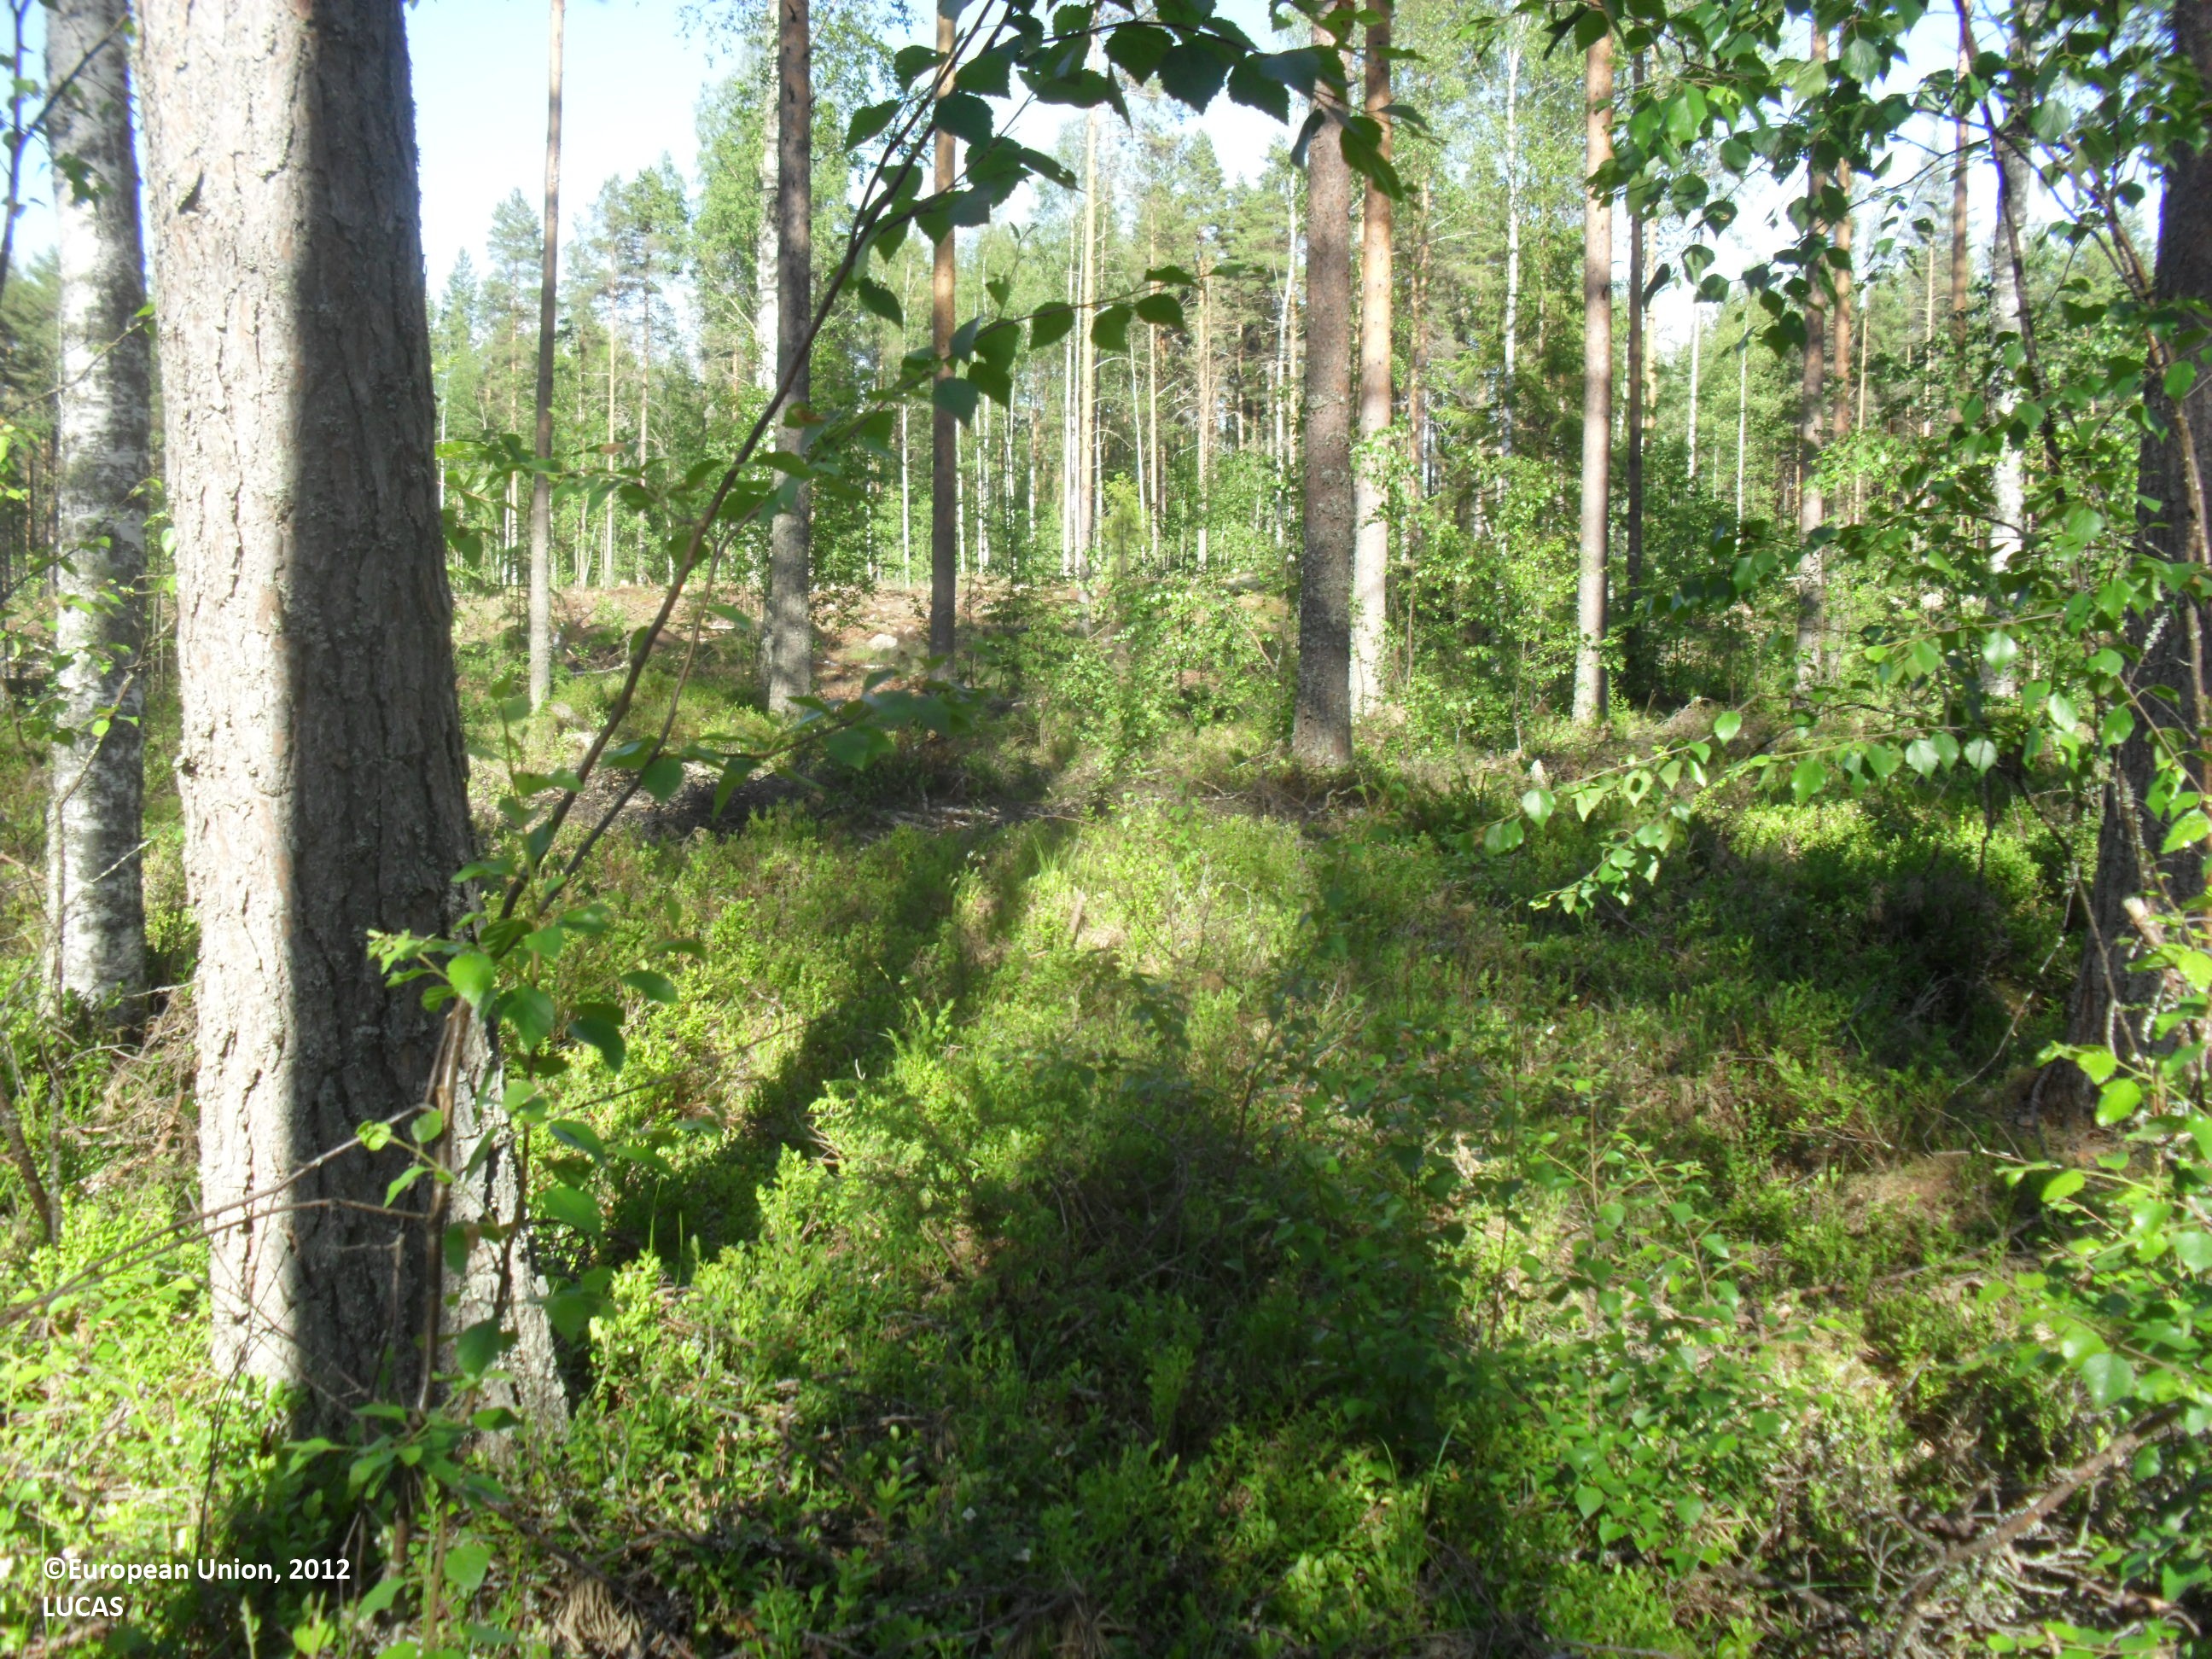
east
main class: Woodland
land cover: Pine dominated mixed woodland
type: boreal forest
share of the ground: 50 - 75 %
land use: Forestry
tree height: > 5 m
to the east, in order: Pine dominated mixed woodland; Spontaneously vegetated surfaces; Pine dominated mixed woodland; Pine dominated coniferous woodland; Paved roads, cycling and walking lanes; Pine dominated coniferous woodland
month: June
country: FI
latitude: 62.9665
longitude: 23.7778
